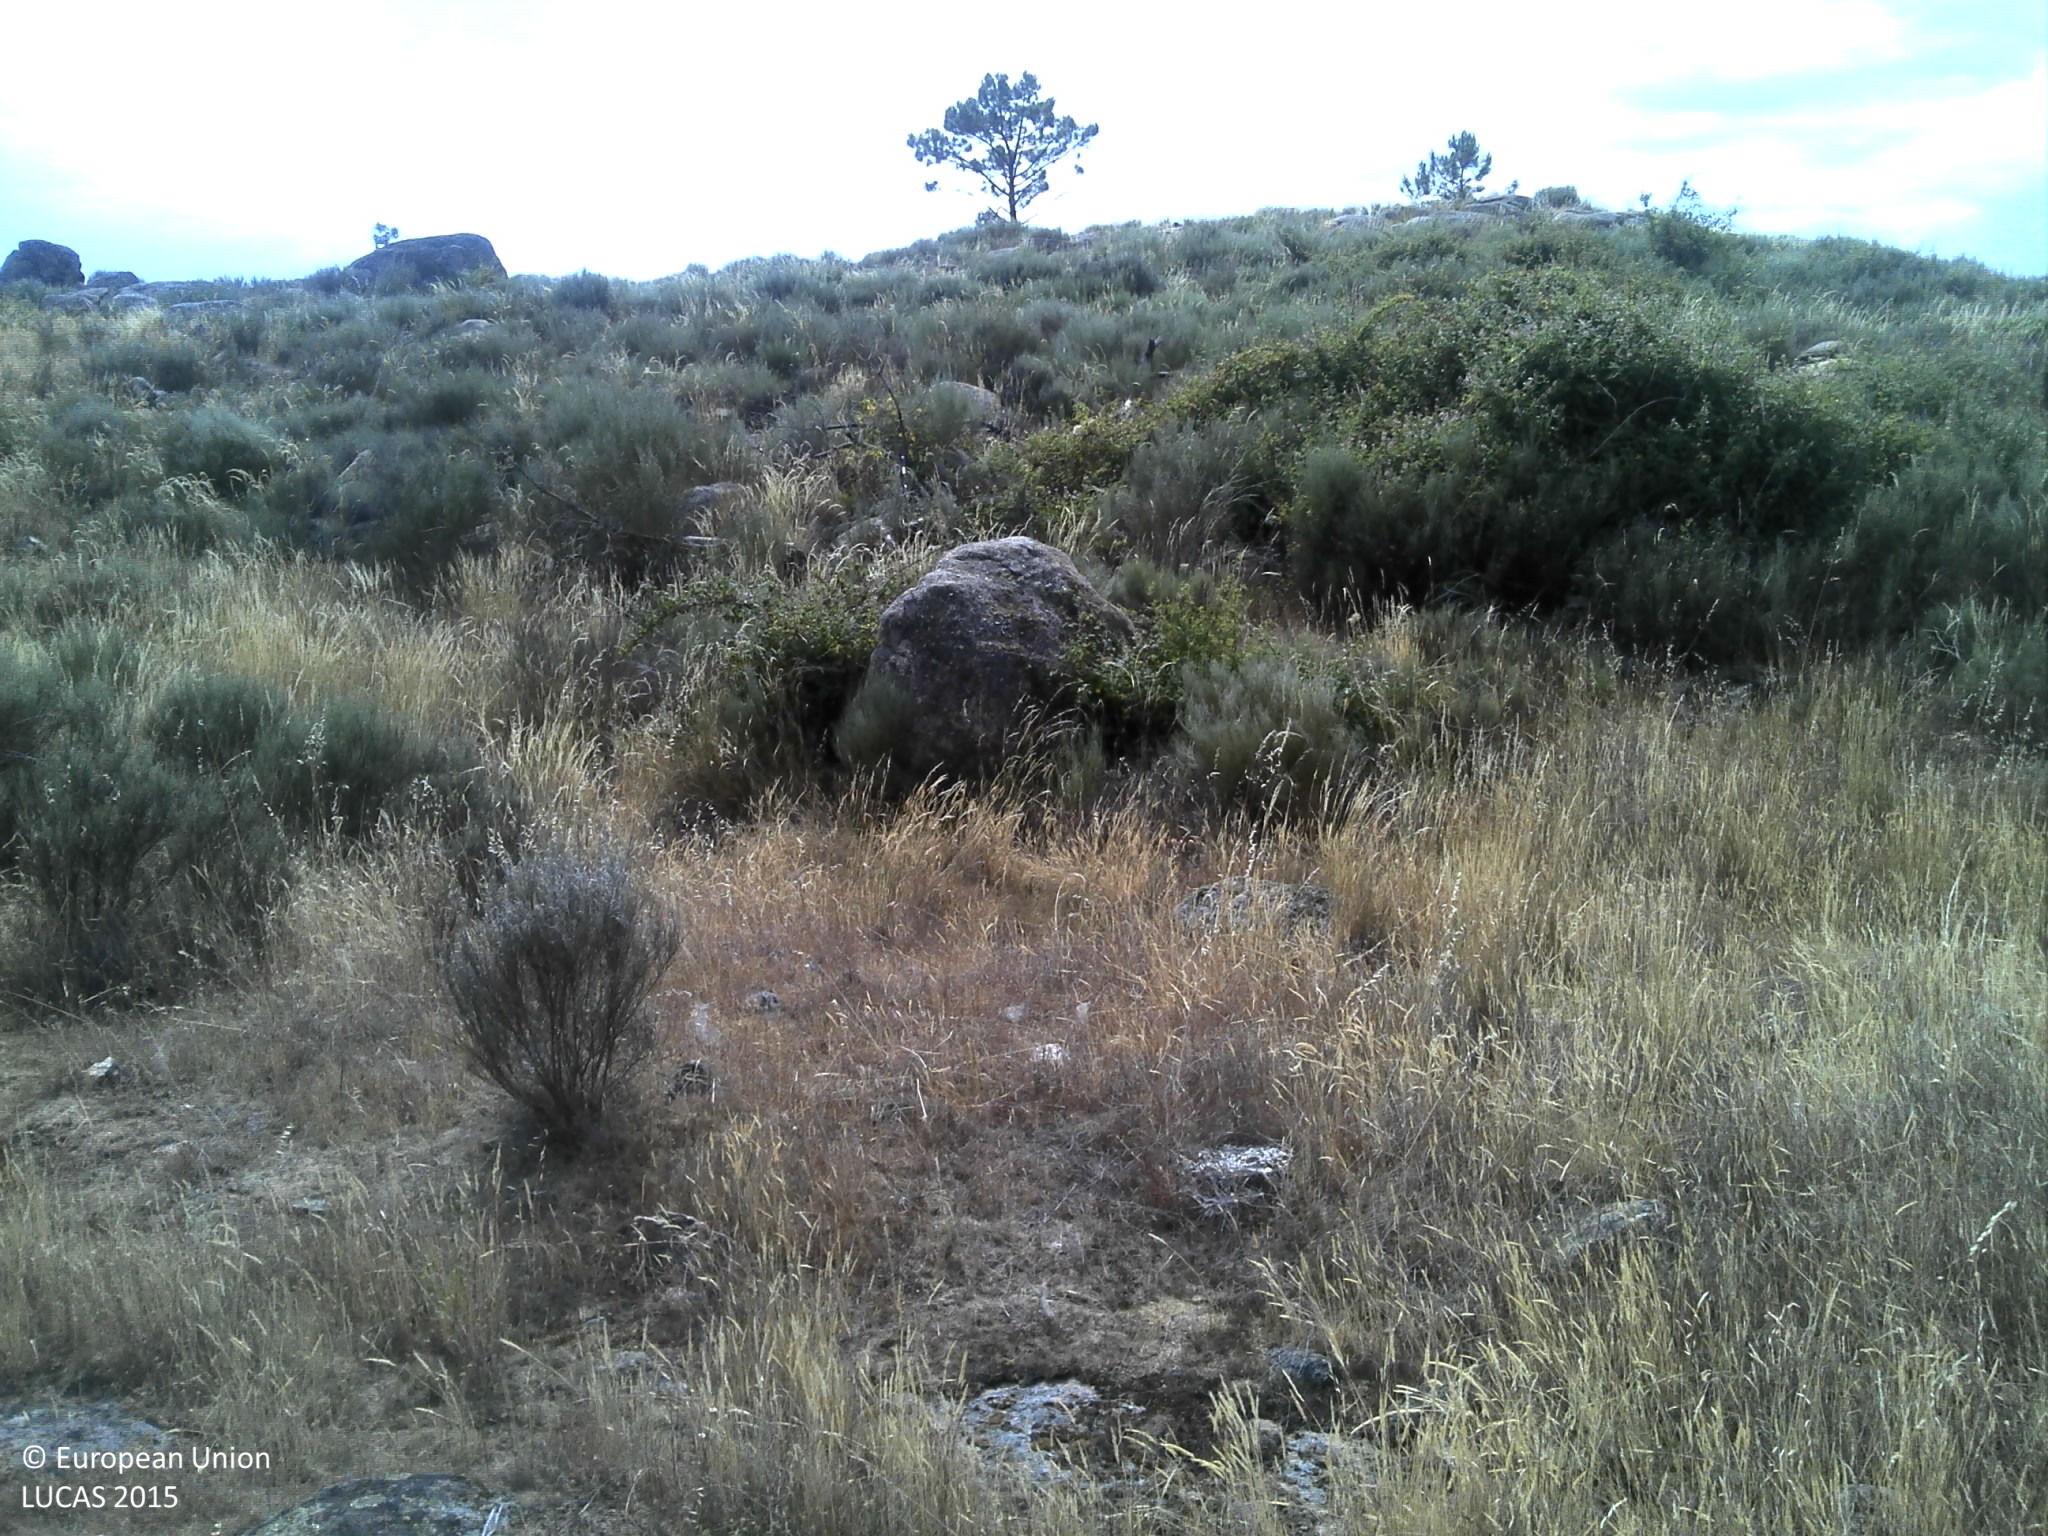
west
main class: Shrubland
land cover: Shrubland without tree cover
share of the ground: 50 - 75 %
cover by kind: shrubs 55 %, herbaceous plants 25 %, unconsolidated bare surface 20 %
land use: Abandoned areas
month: June
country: PT
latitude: 40.3053
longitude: -7.2924
